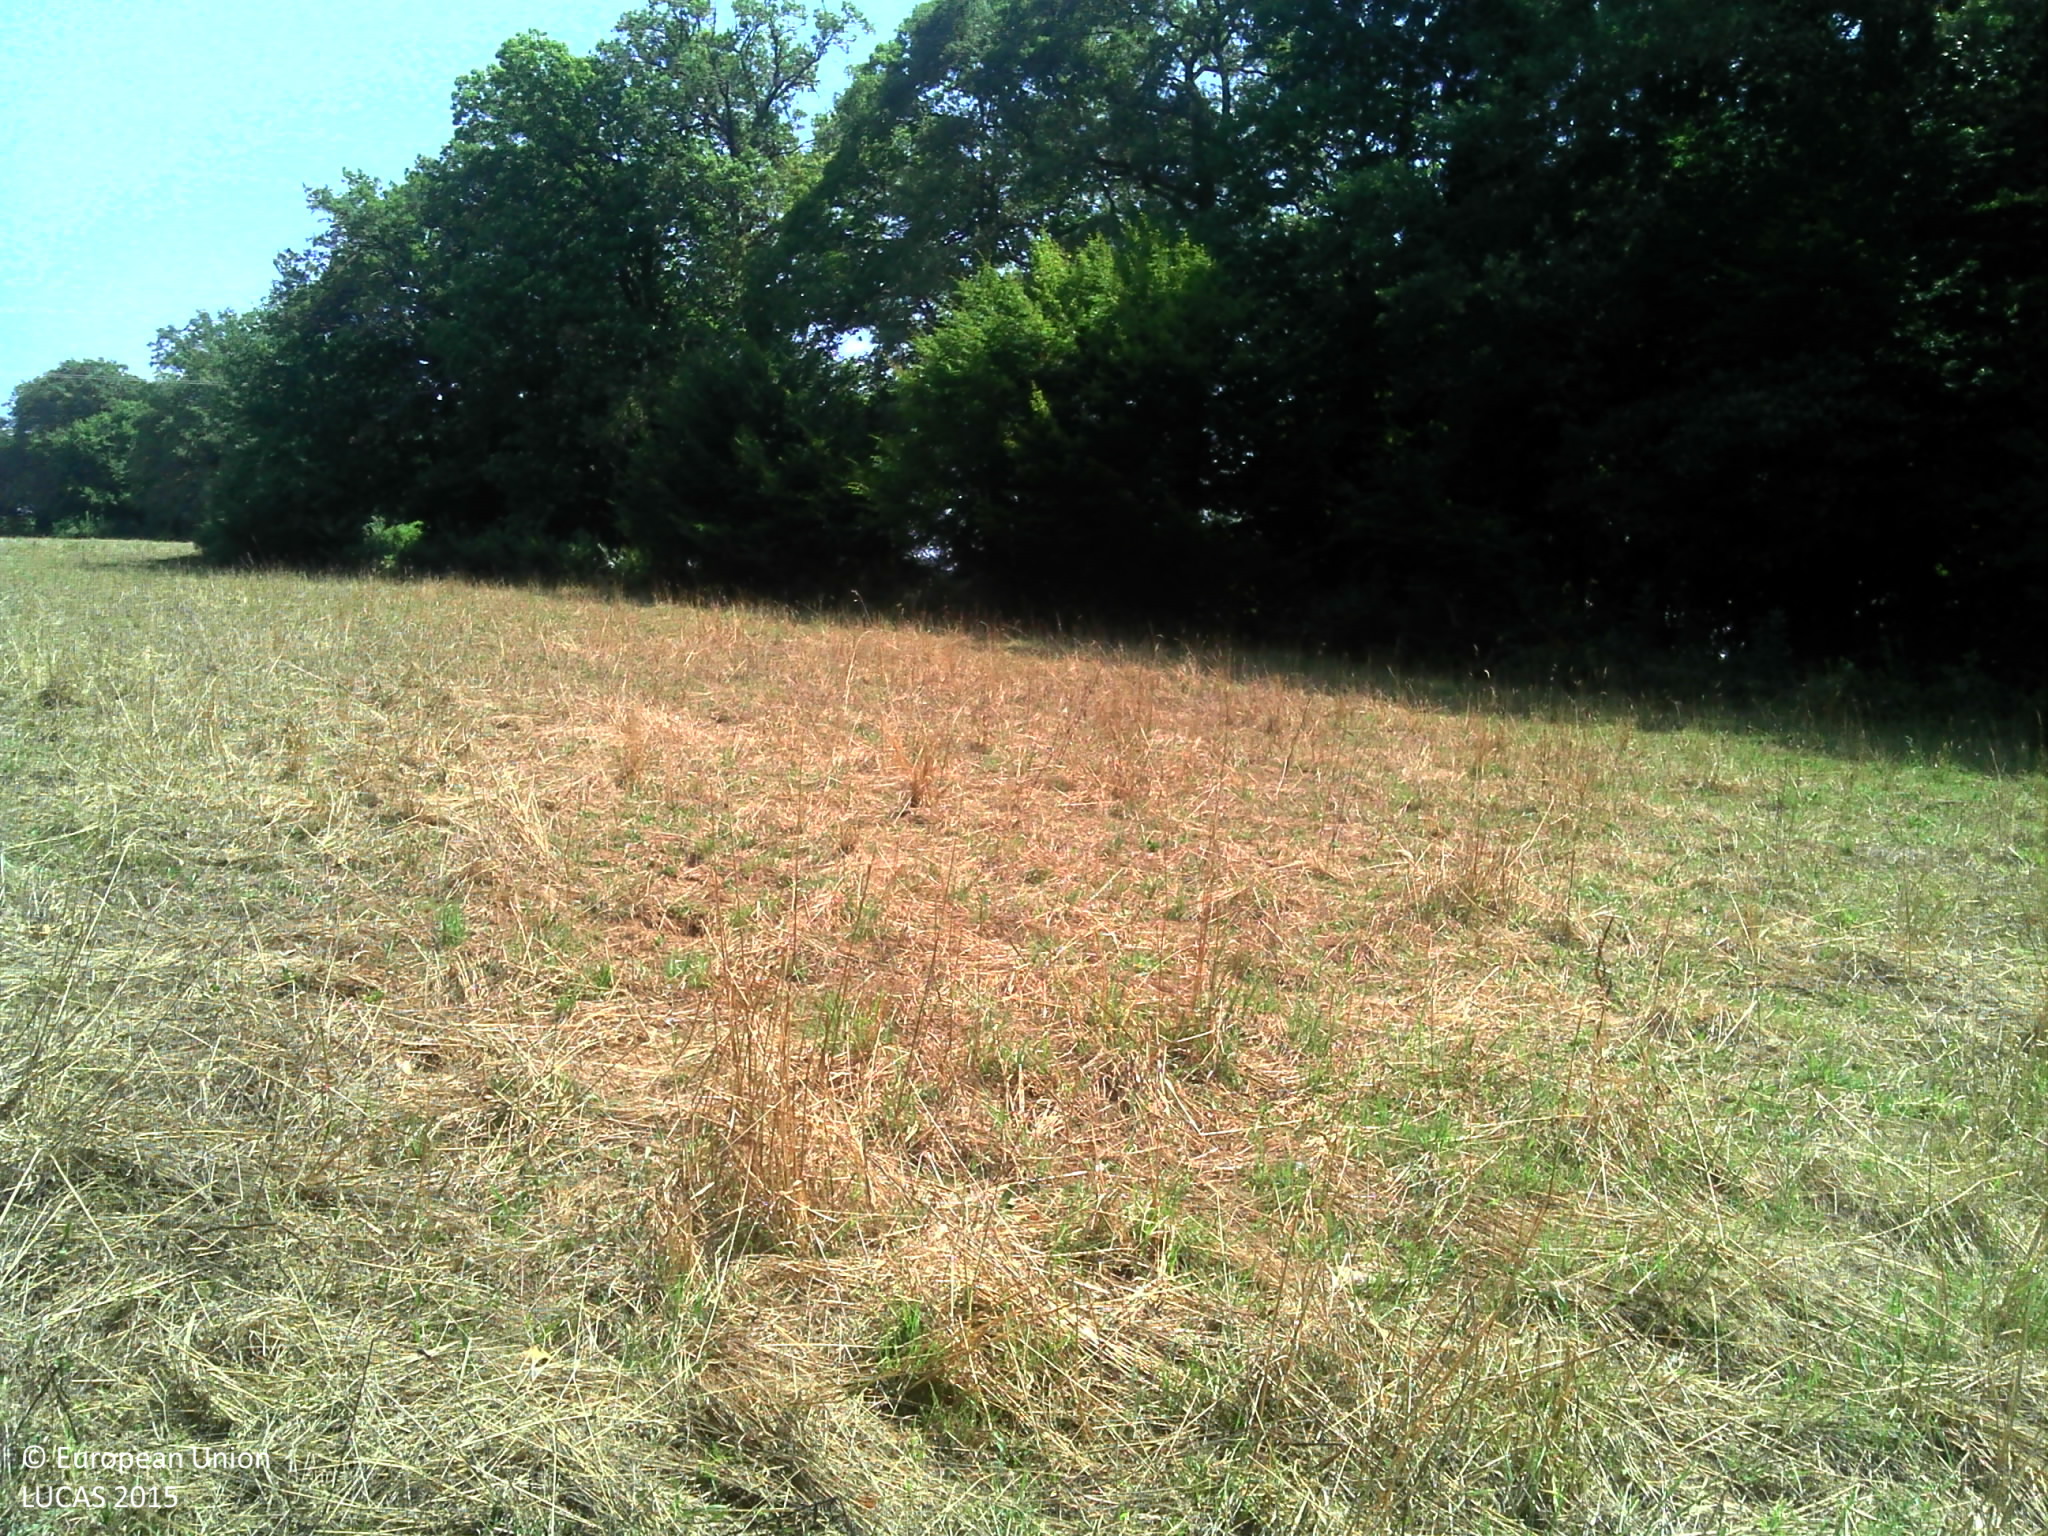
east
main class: Grassland
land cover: Grassland without tree/shrub cover
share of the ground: > 75 %
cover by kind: herbaceous plants 100 %
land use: Agriculture (excluding fallow land and kitchen gardens)
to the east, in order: Grassland without tree/shrub cover; Fences; Managed hedges; Grass margins; Paved roads, cycling and walking lanes; Grass margins; Fences; Lines of trees; Grassland without tree/shrub cover; Electric lines; Grassland without tree/shrub cover
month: August
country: FR
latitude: 45.4188
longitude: 1.7784
